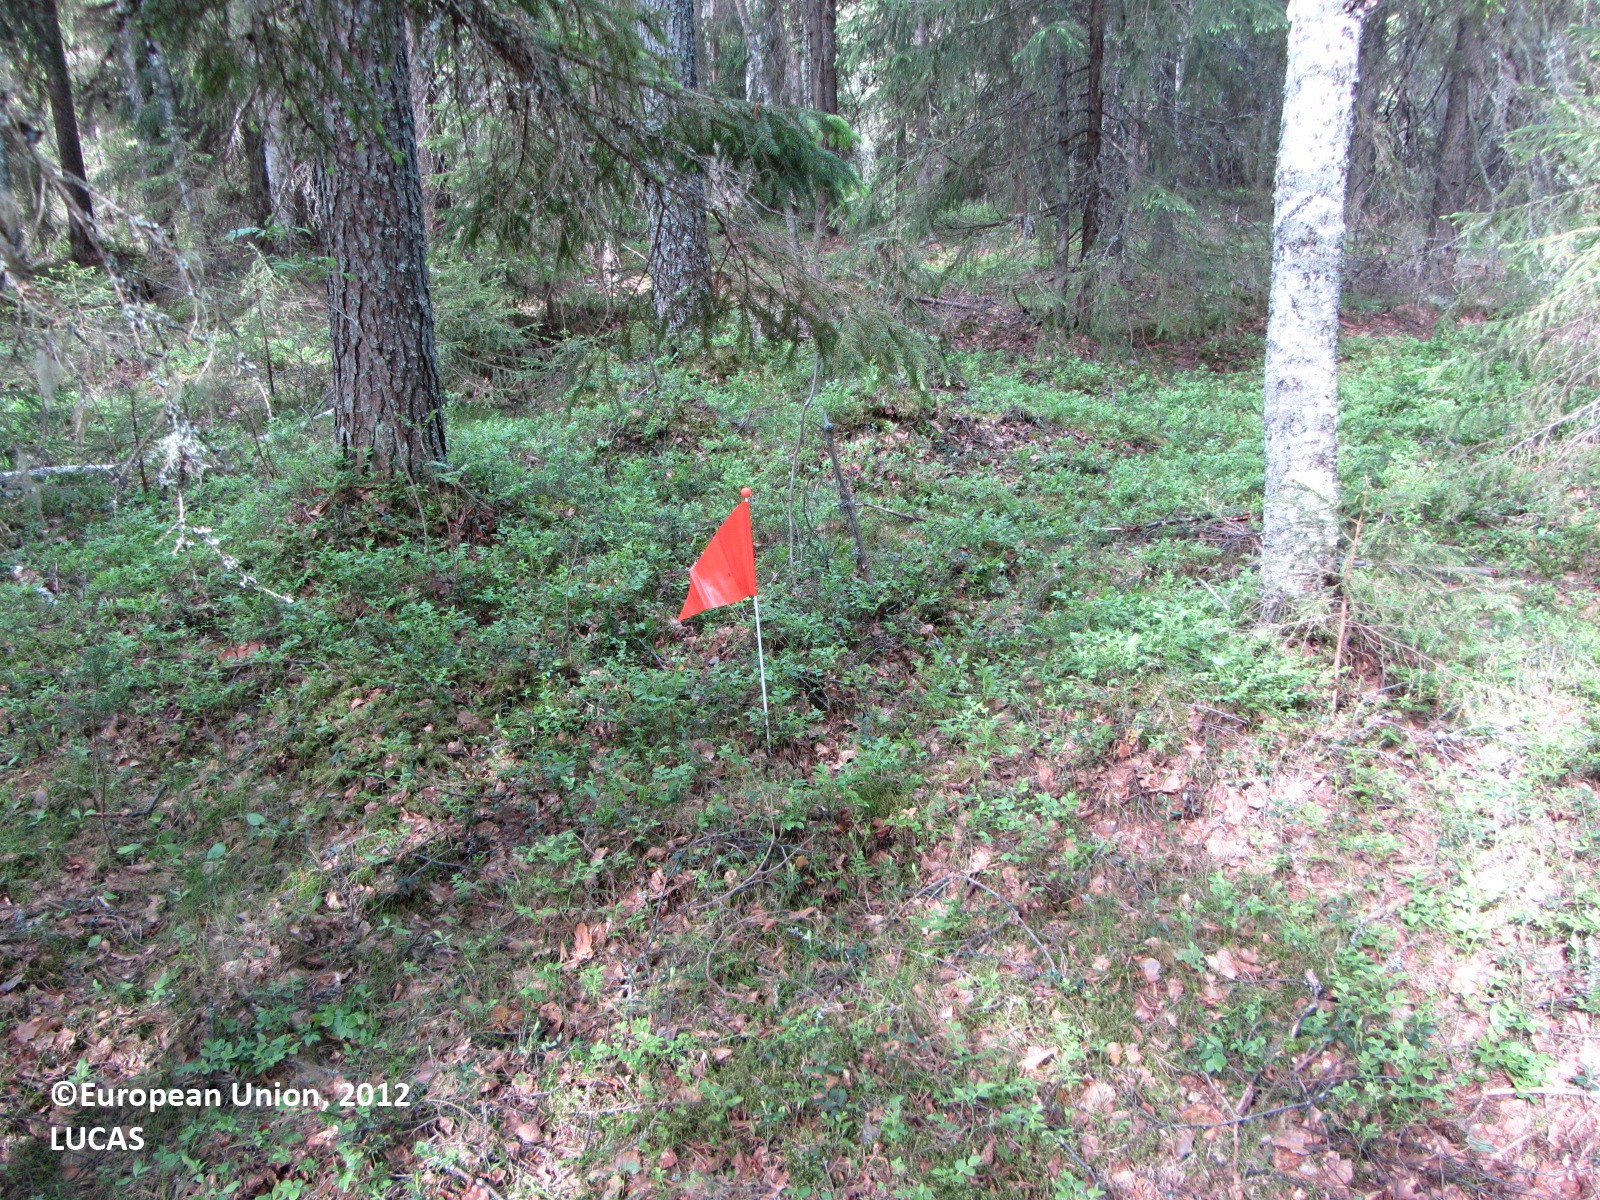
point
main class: Woodland
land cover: Spruce dominated mixed woodland
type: boreal forest
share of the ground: > 75 %
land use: Forestry
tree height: > 5 m
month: June
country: FI
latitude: 61.8034
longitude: 24.9607
